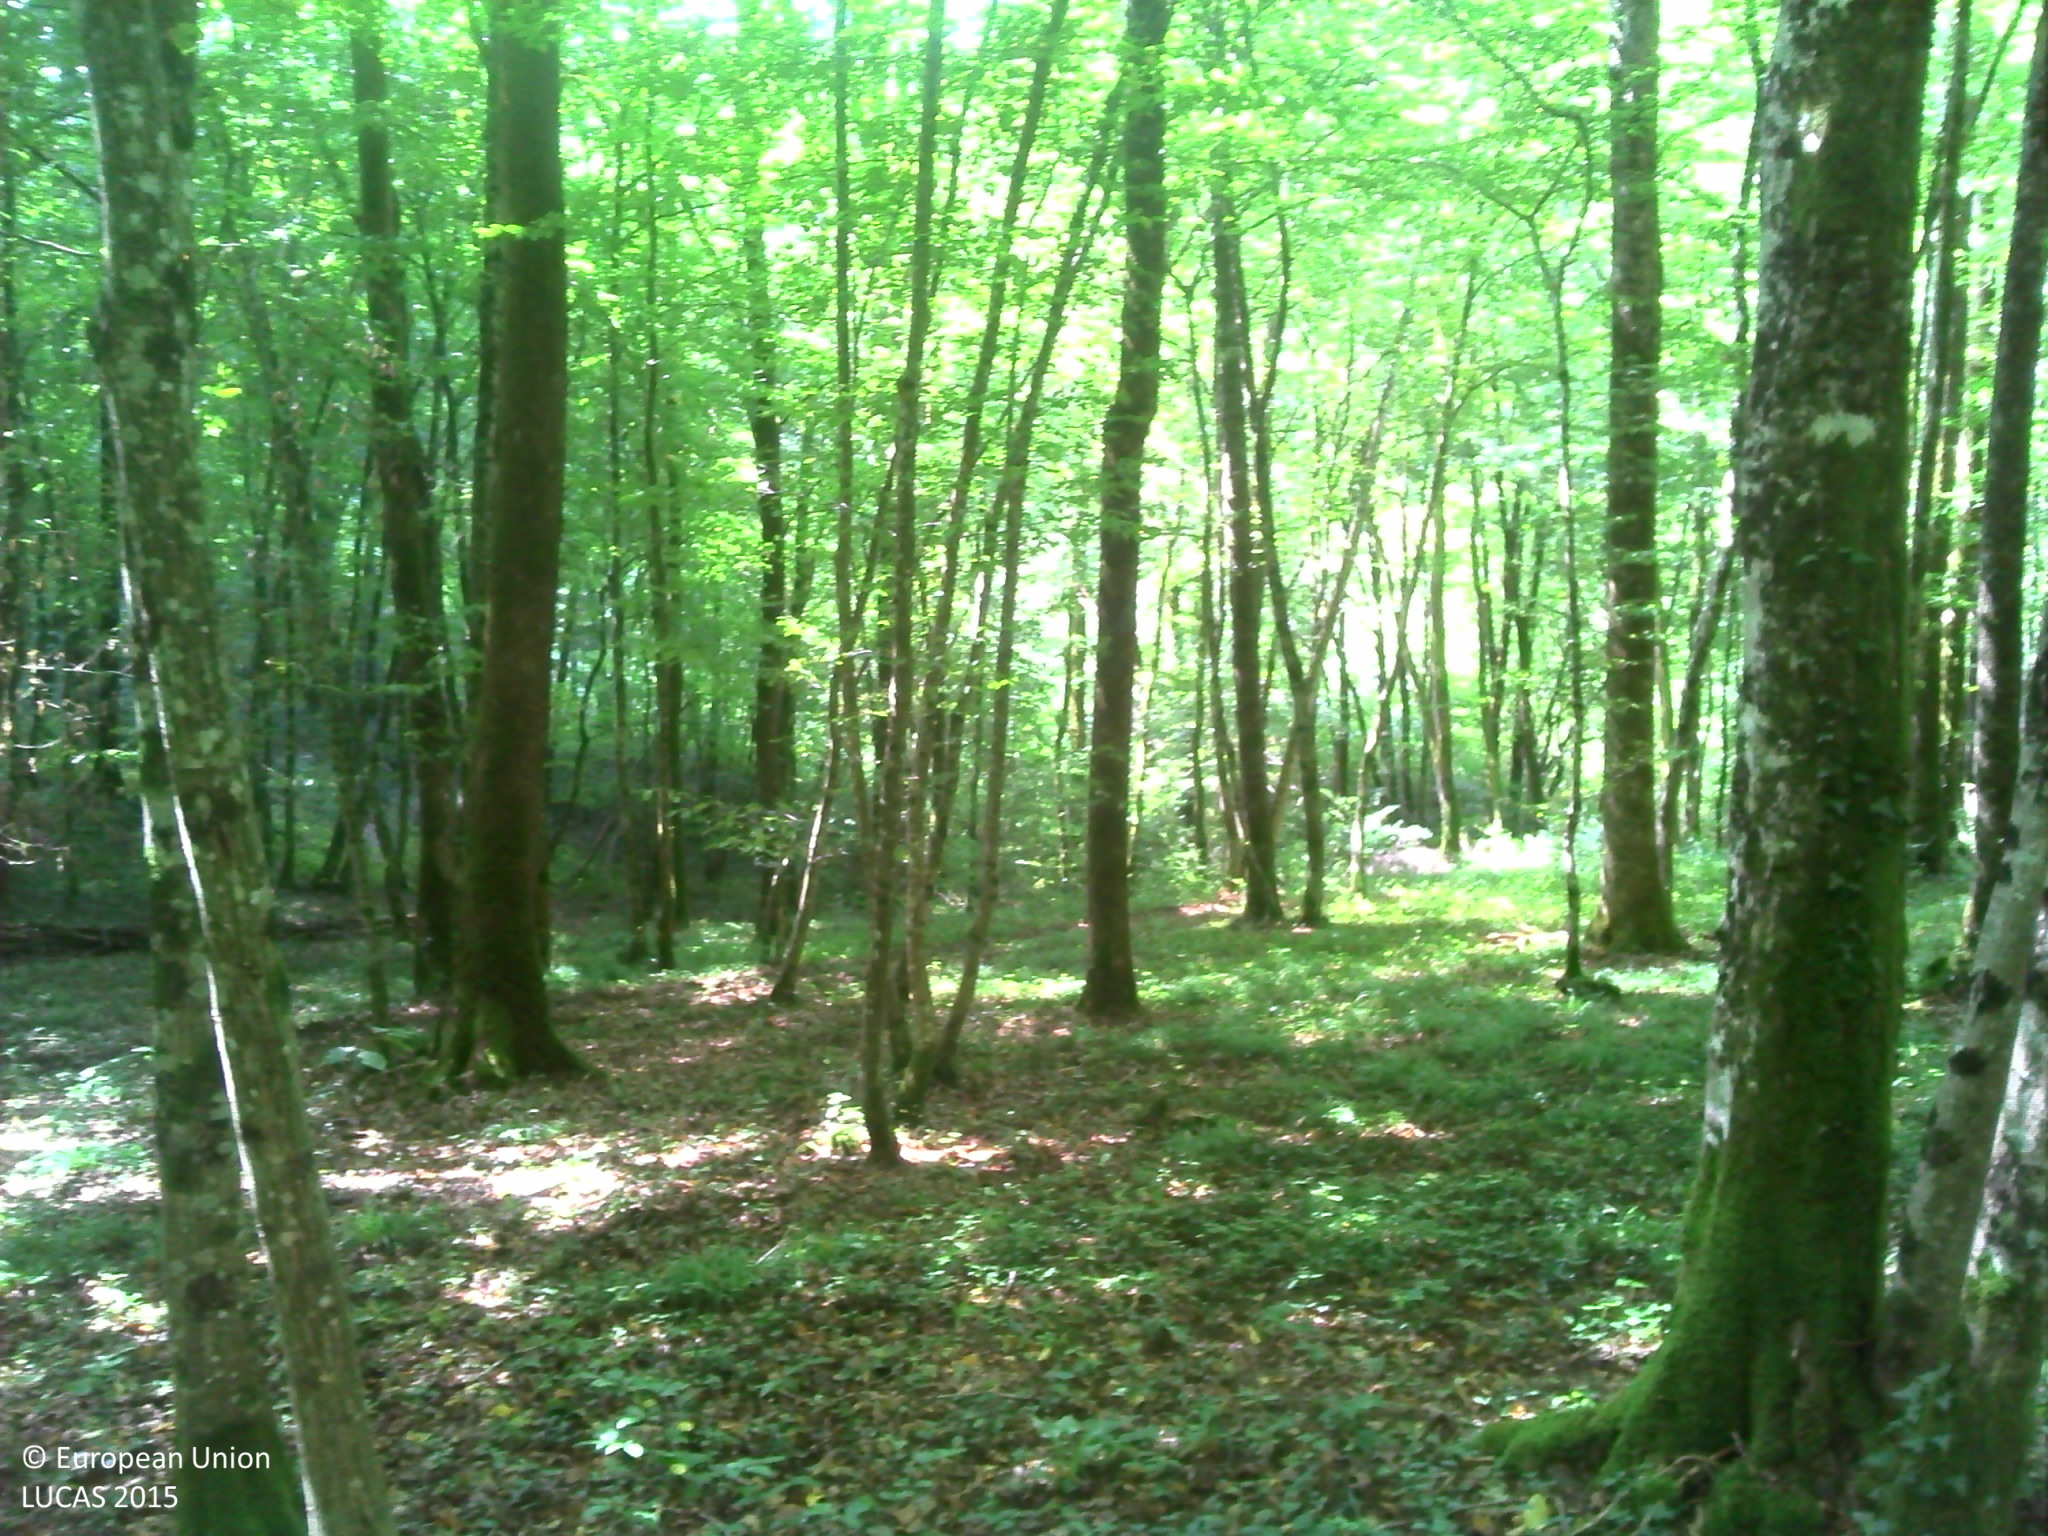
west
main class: Woodland
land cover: Broadleaved woodland
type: mesophytic deciduous forest
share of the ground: > 75 %
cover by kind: broadleaved forest trees 90 %, herbaceous plants 10 %
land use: Forestry
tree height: > 5 m
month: September
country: FR
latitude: 47.4404
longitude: 6.8591
